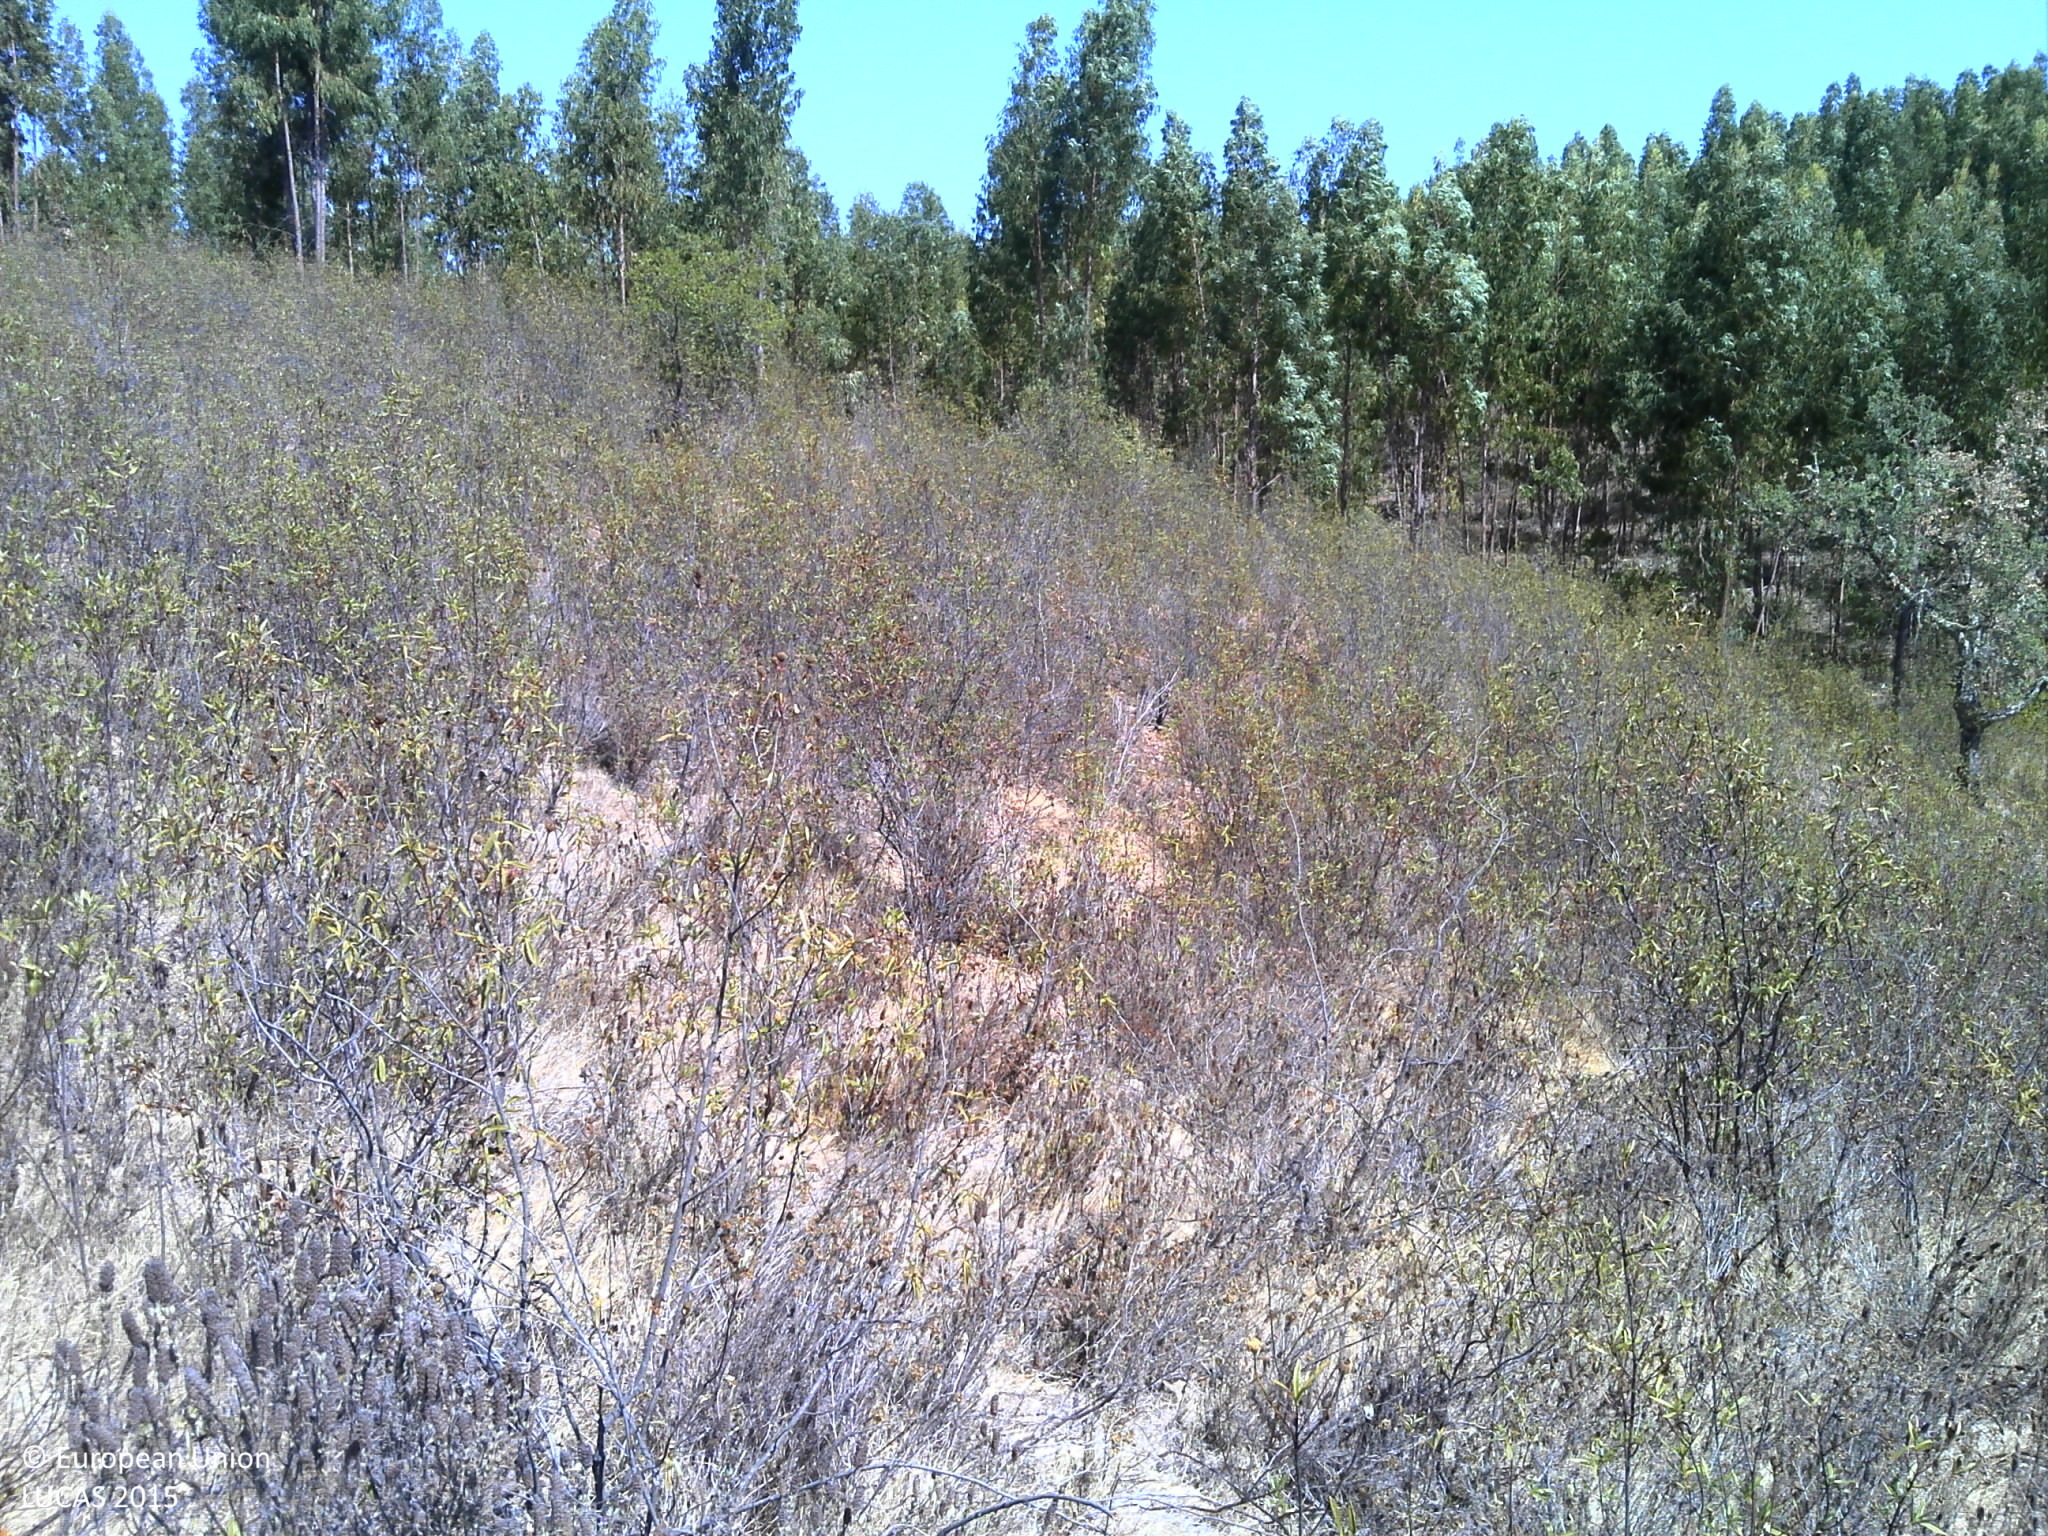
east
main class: Shrubland
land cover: Shrubland without tree cover
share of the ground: 50 - 75 %
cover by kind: shrubs 75 %, unconsolidated bare surface 20 %, herbaceous plants 5 %
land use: Forestry
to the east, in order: Shrubland without tree cover; Other structural elements; Broadleaved woodland; Tracks; Broadleaved woodland
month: September
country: PT
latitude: 37.4676
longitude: -8.2404
